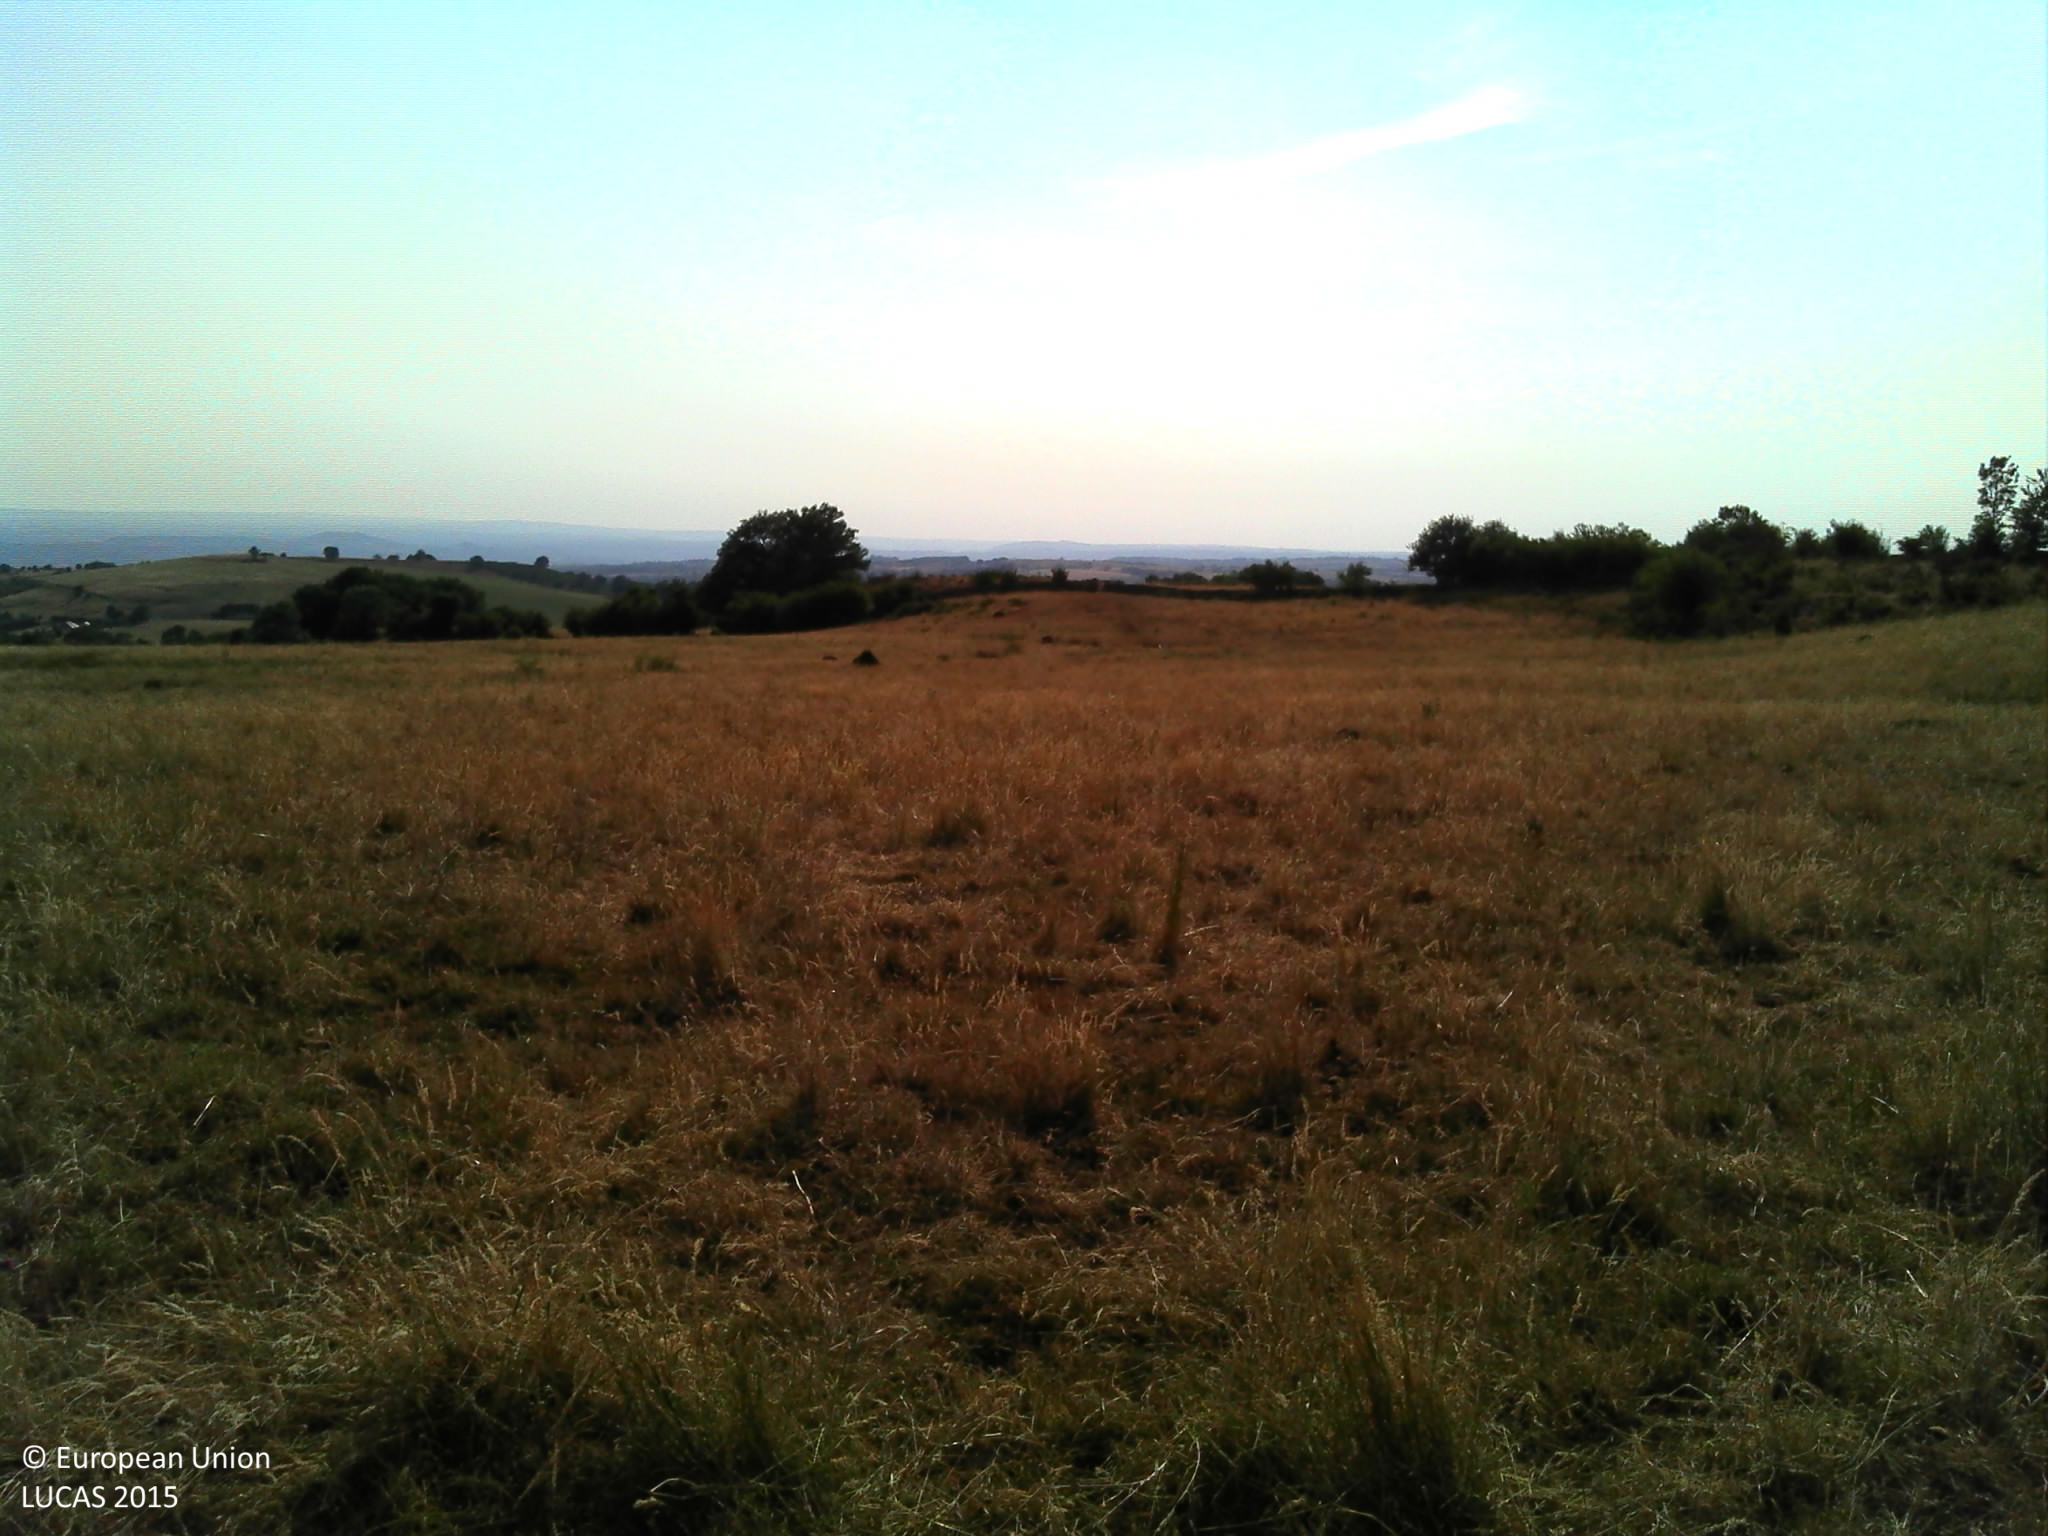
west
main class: Grassland
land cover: Grassland without tree/shrub cover
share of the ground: > 75 %
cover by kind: herbaceous plants 100 %
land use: Agriculture (excluding fallow land and kitchen gardens)
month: July
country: FR
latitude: 44.5804
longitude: 2.9382
